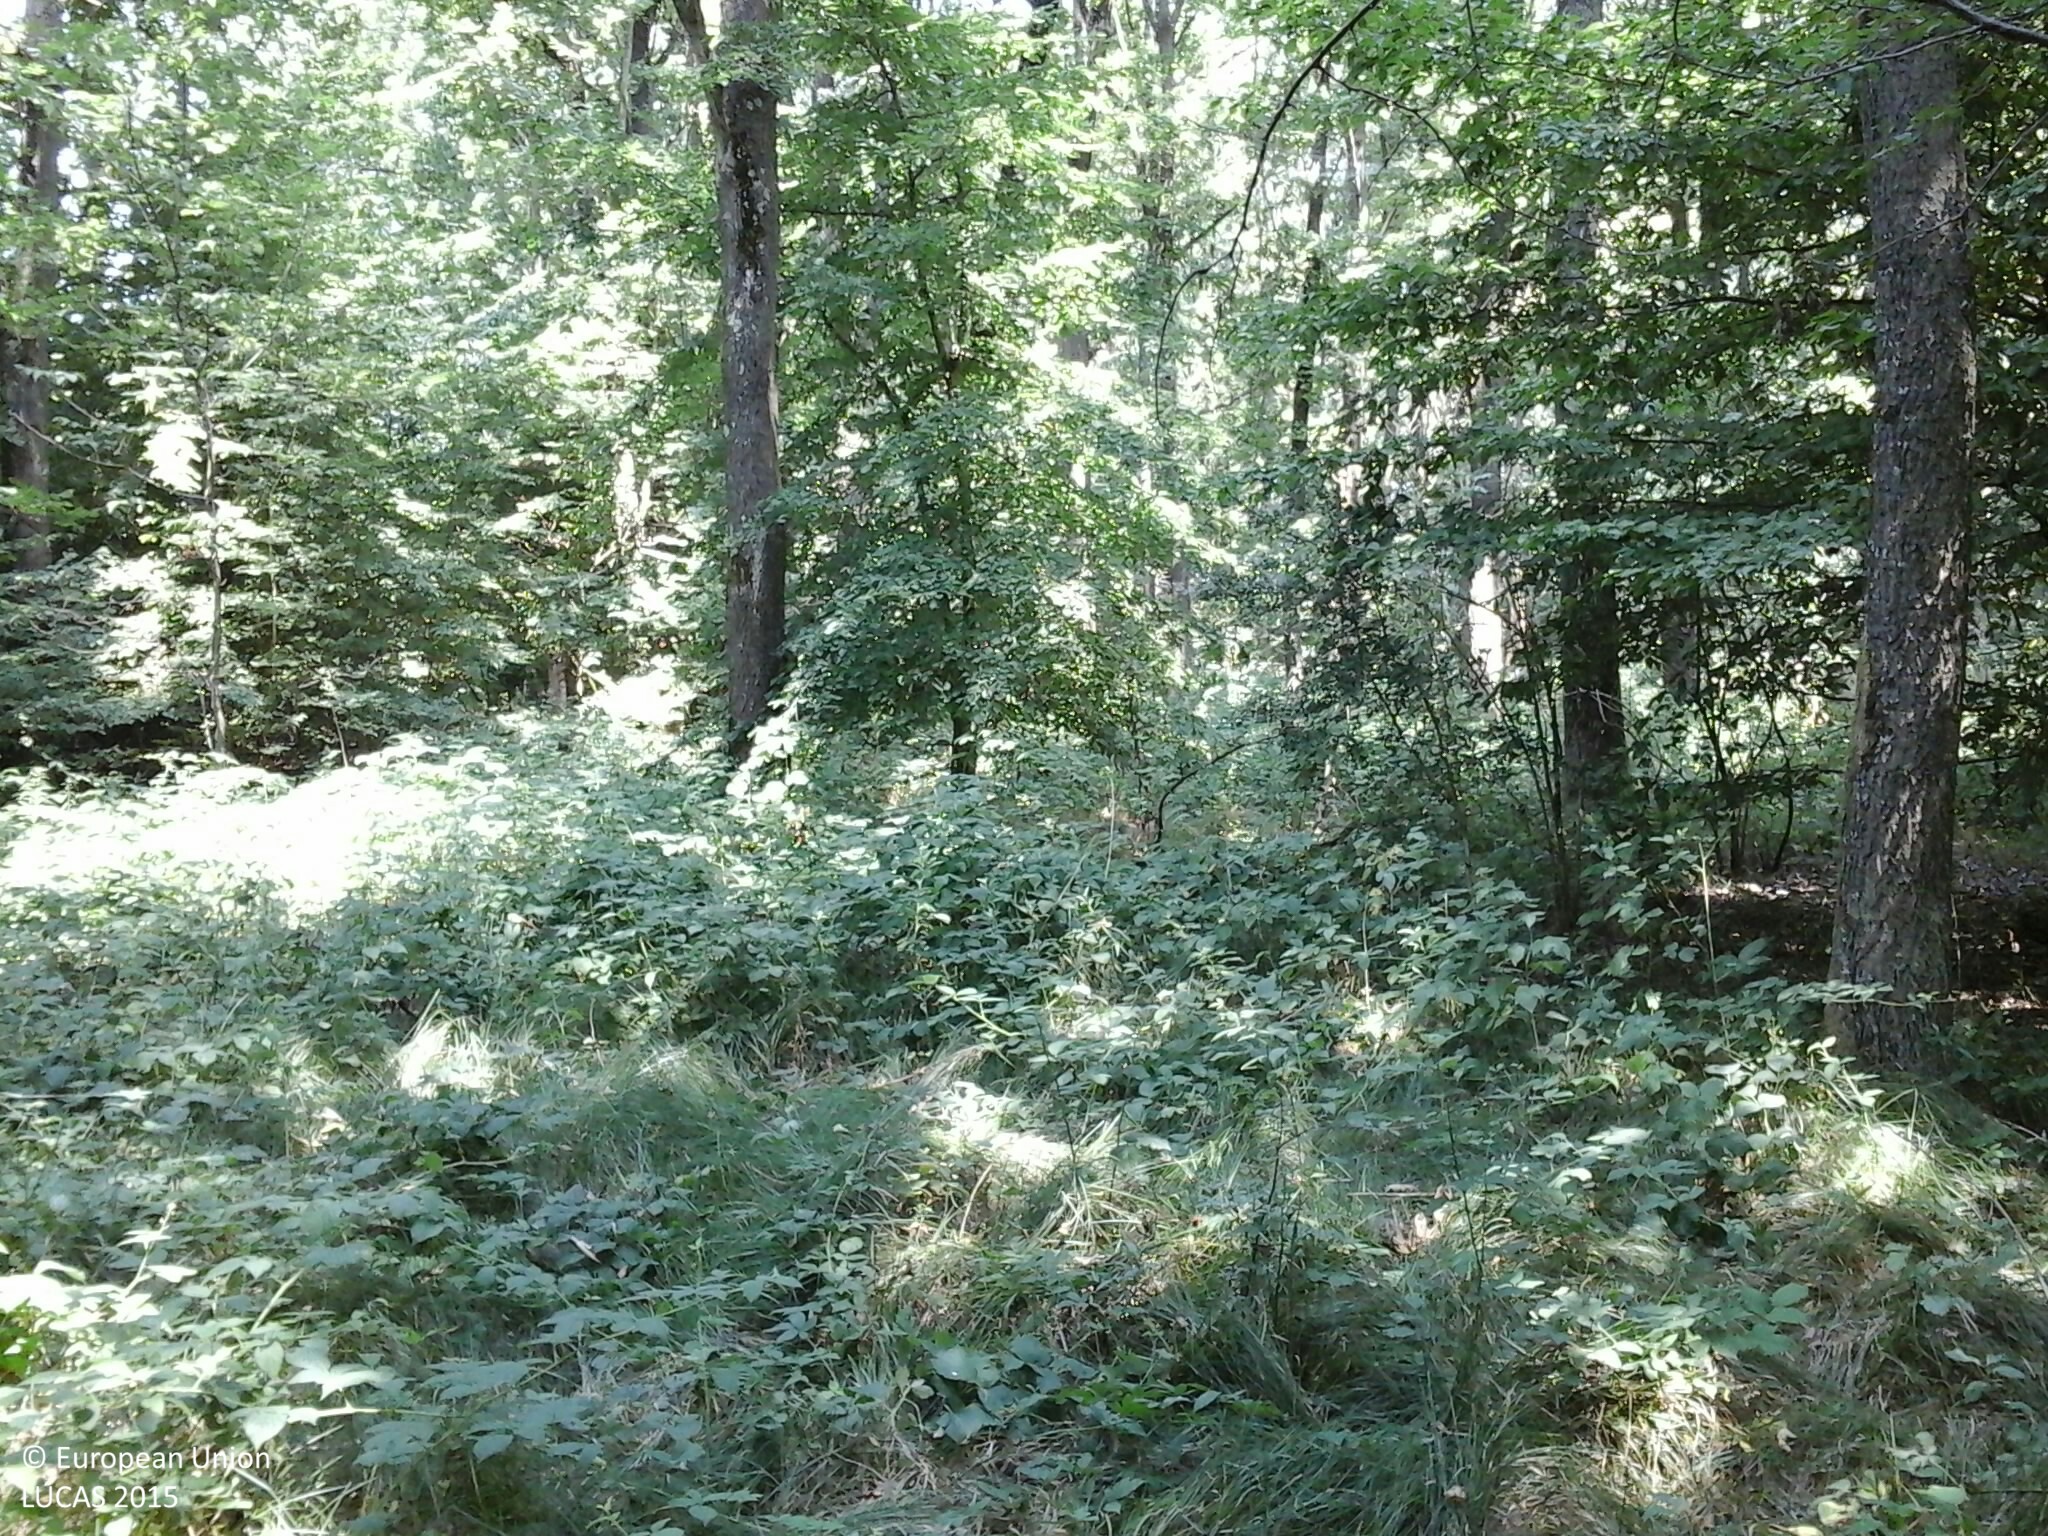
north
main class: Woodland
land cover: Broadleaved woodland
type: beech forest
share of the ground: > 75 %
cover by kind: broadleaved forest trees 65 %, shrubs 20 %, herbaceous plants 15 %
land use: Forestry
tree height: > 5 m
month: July
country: HU
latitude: 46.6384
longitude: 16.5464
